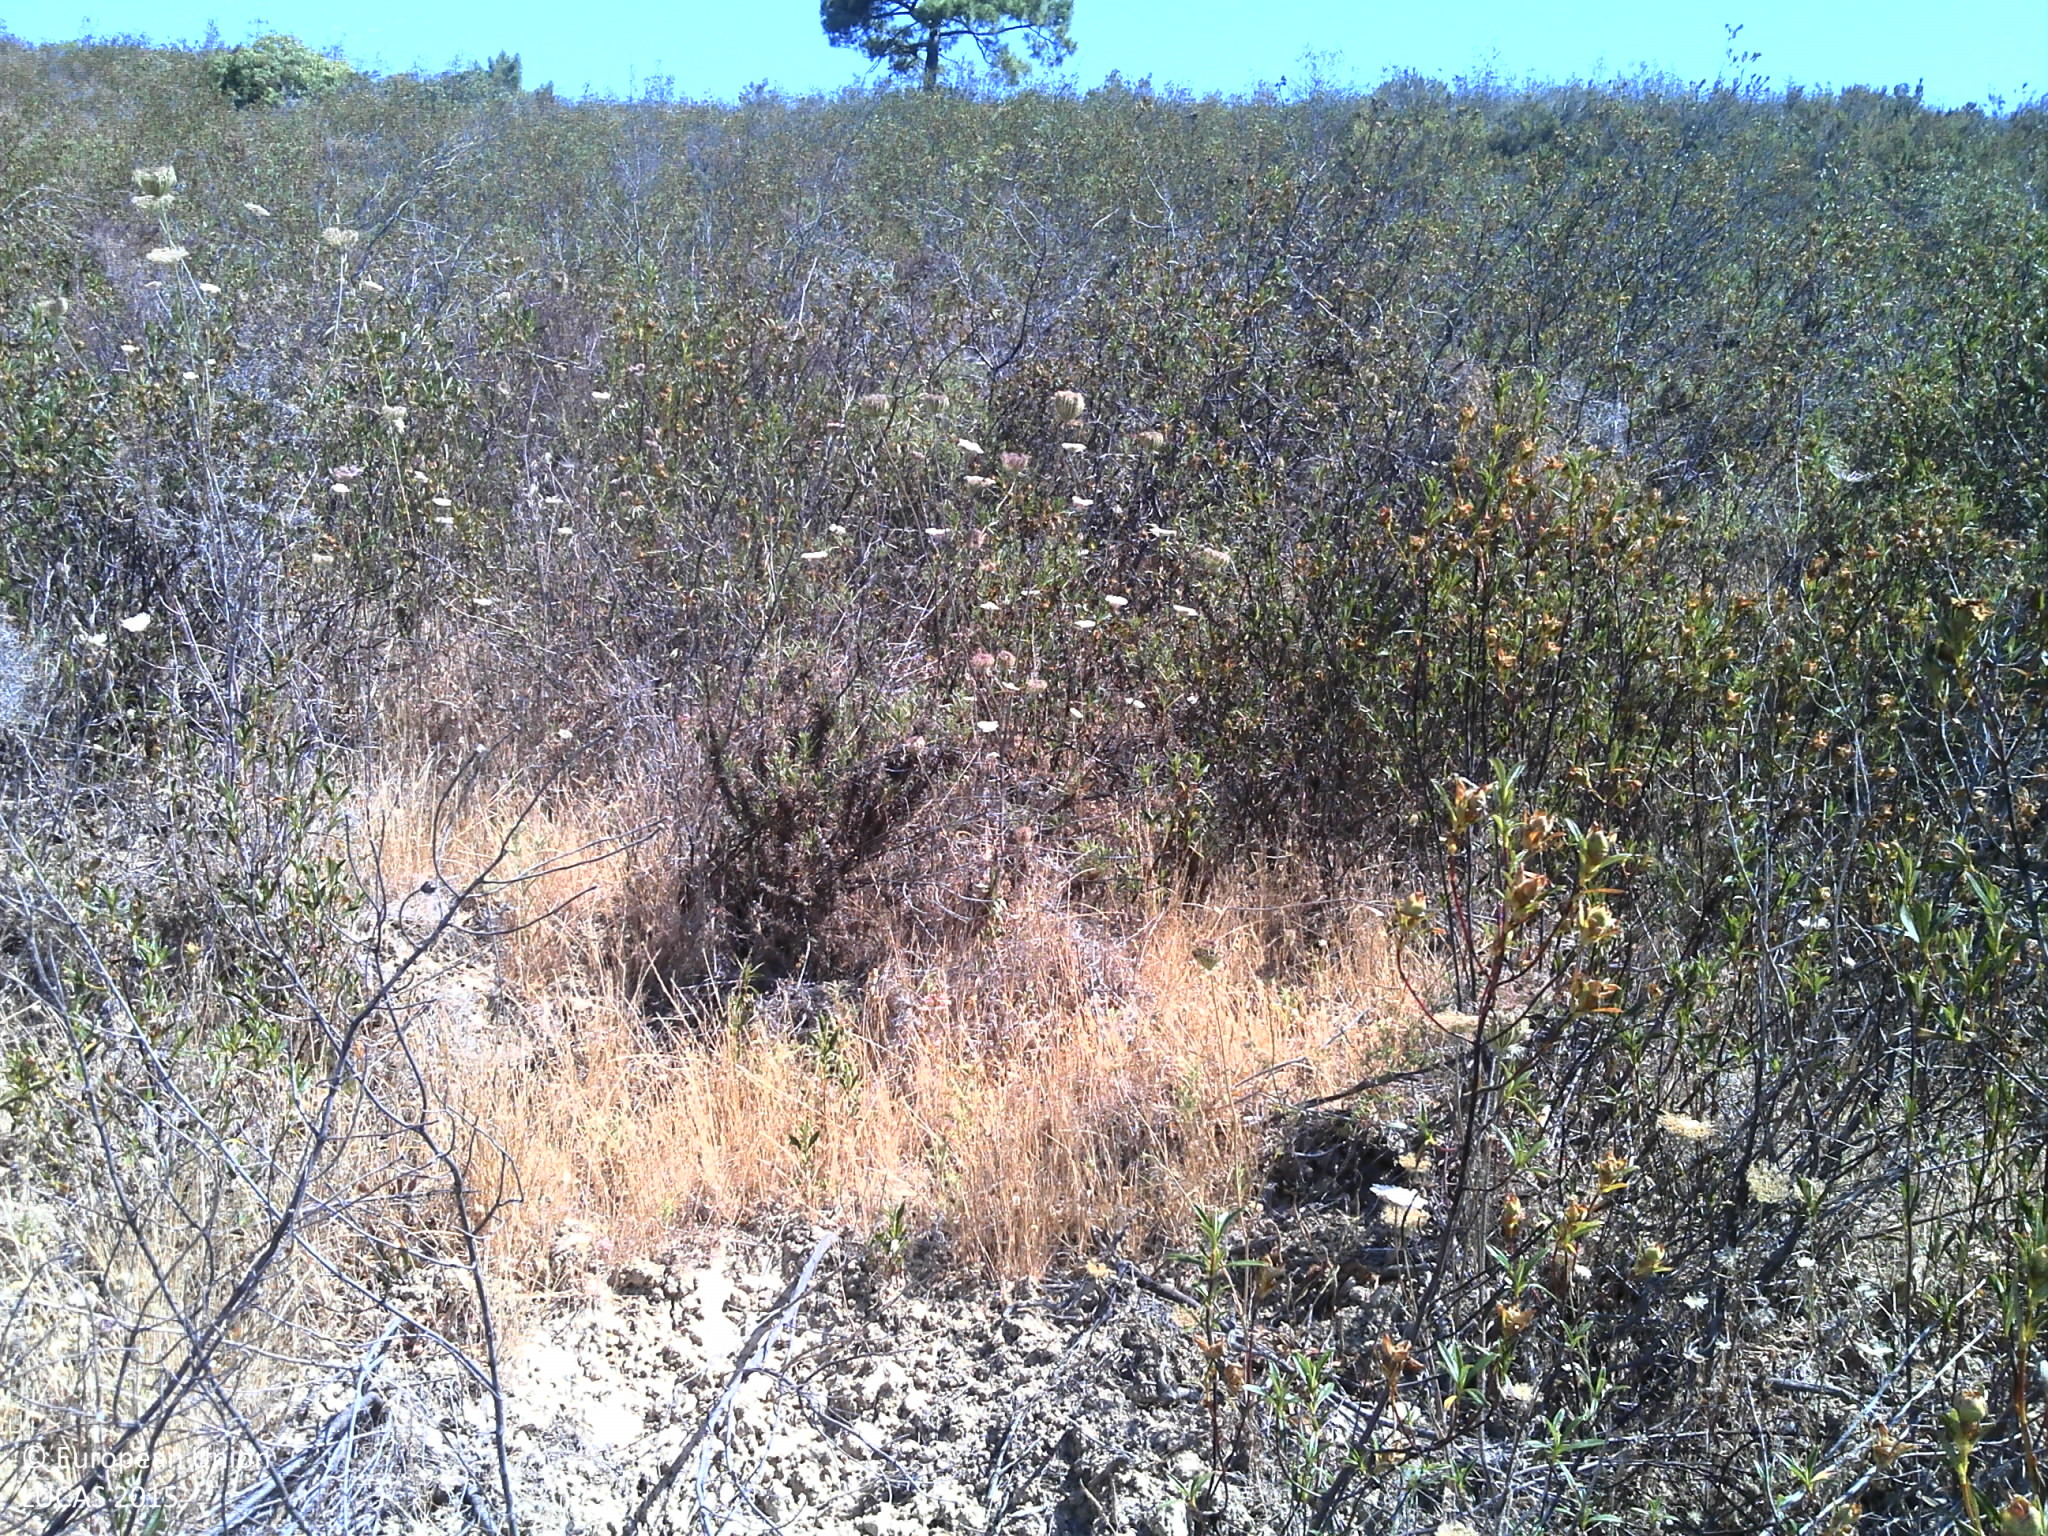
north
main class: Shrubland
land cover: Shrubland without tree cover
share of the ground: > 75 %
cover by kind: shrubs 80 %, unconsolidated bare surface 20 %
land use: Abandoned areas
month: June
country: PT
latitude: 37.4376
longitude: -8.7655
